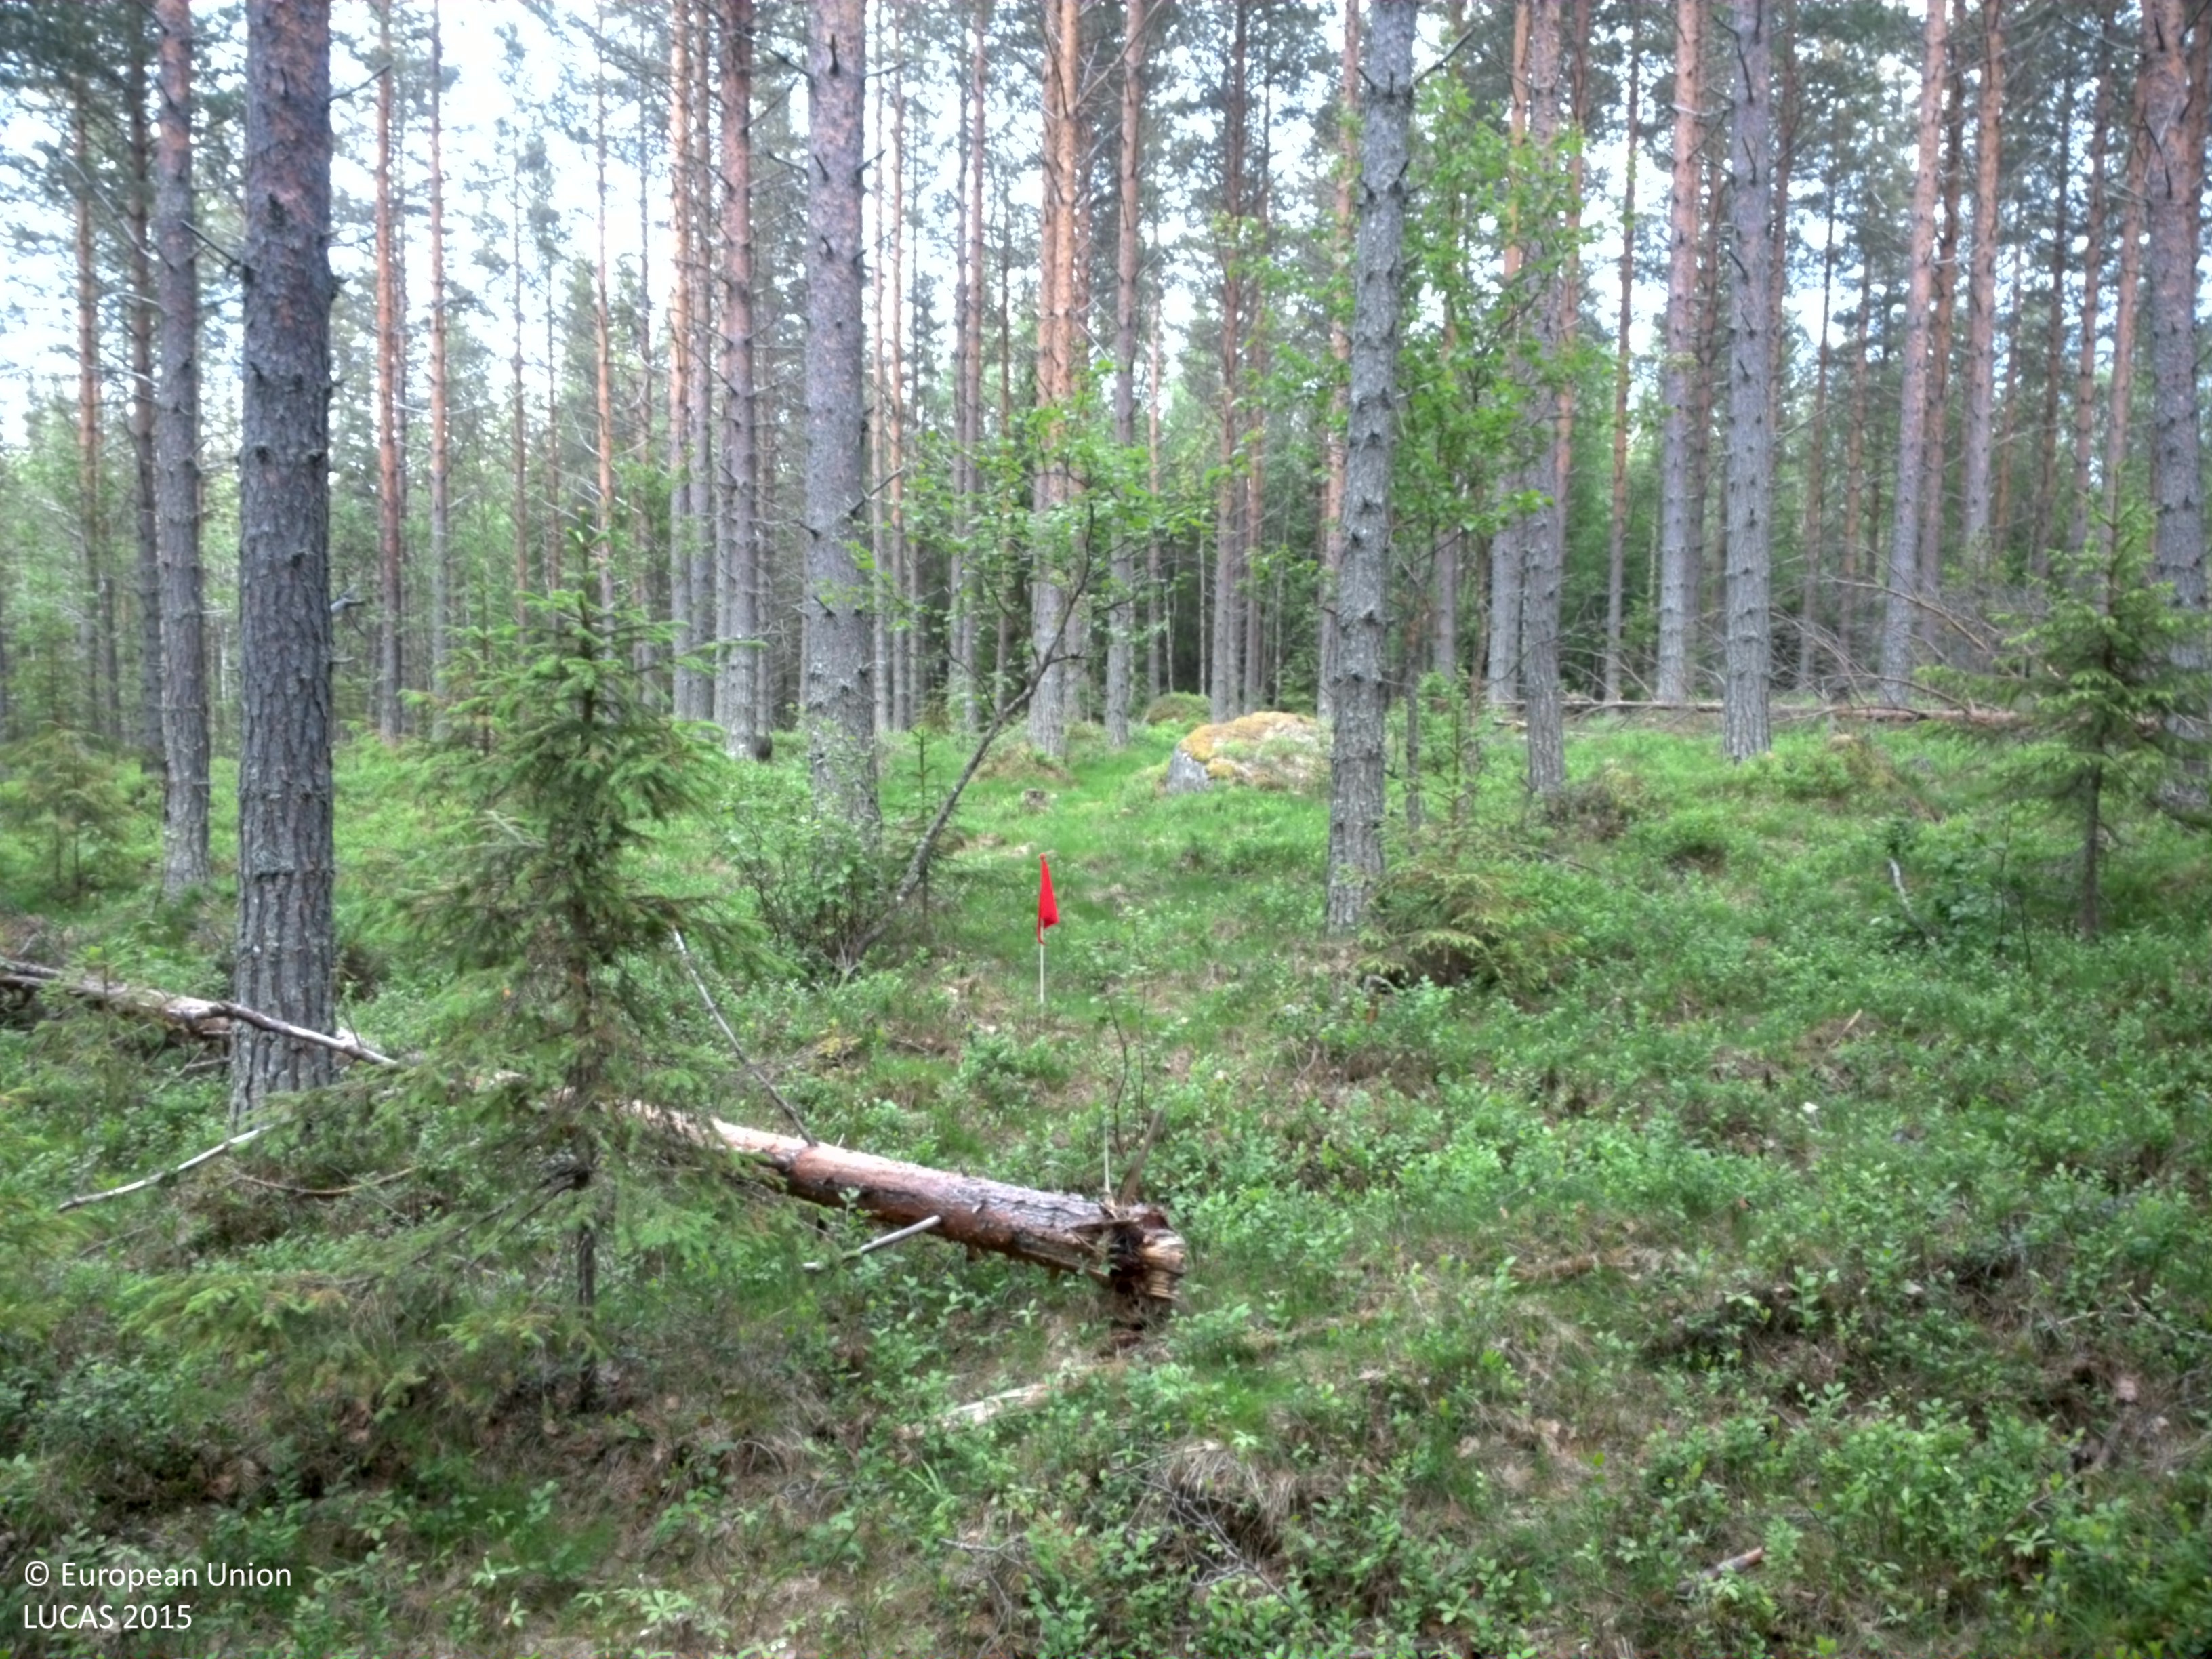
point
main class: Woodland
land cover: Pine dominated mixed woodland
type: boreal forest
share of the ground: 50 - 75 %
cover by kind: coniferous forest trees 45 %, shrubs 30 %, broadleaved forest trees 15 %, herbaceous plants 10 %
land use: Forestry
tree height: > 5 m
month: August
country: SE
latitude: 64.5291
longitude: 18.2414
